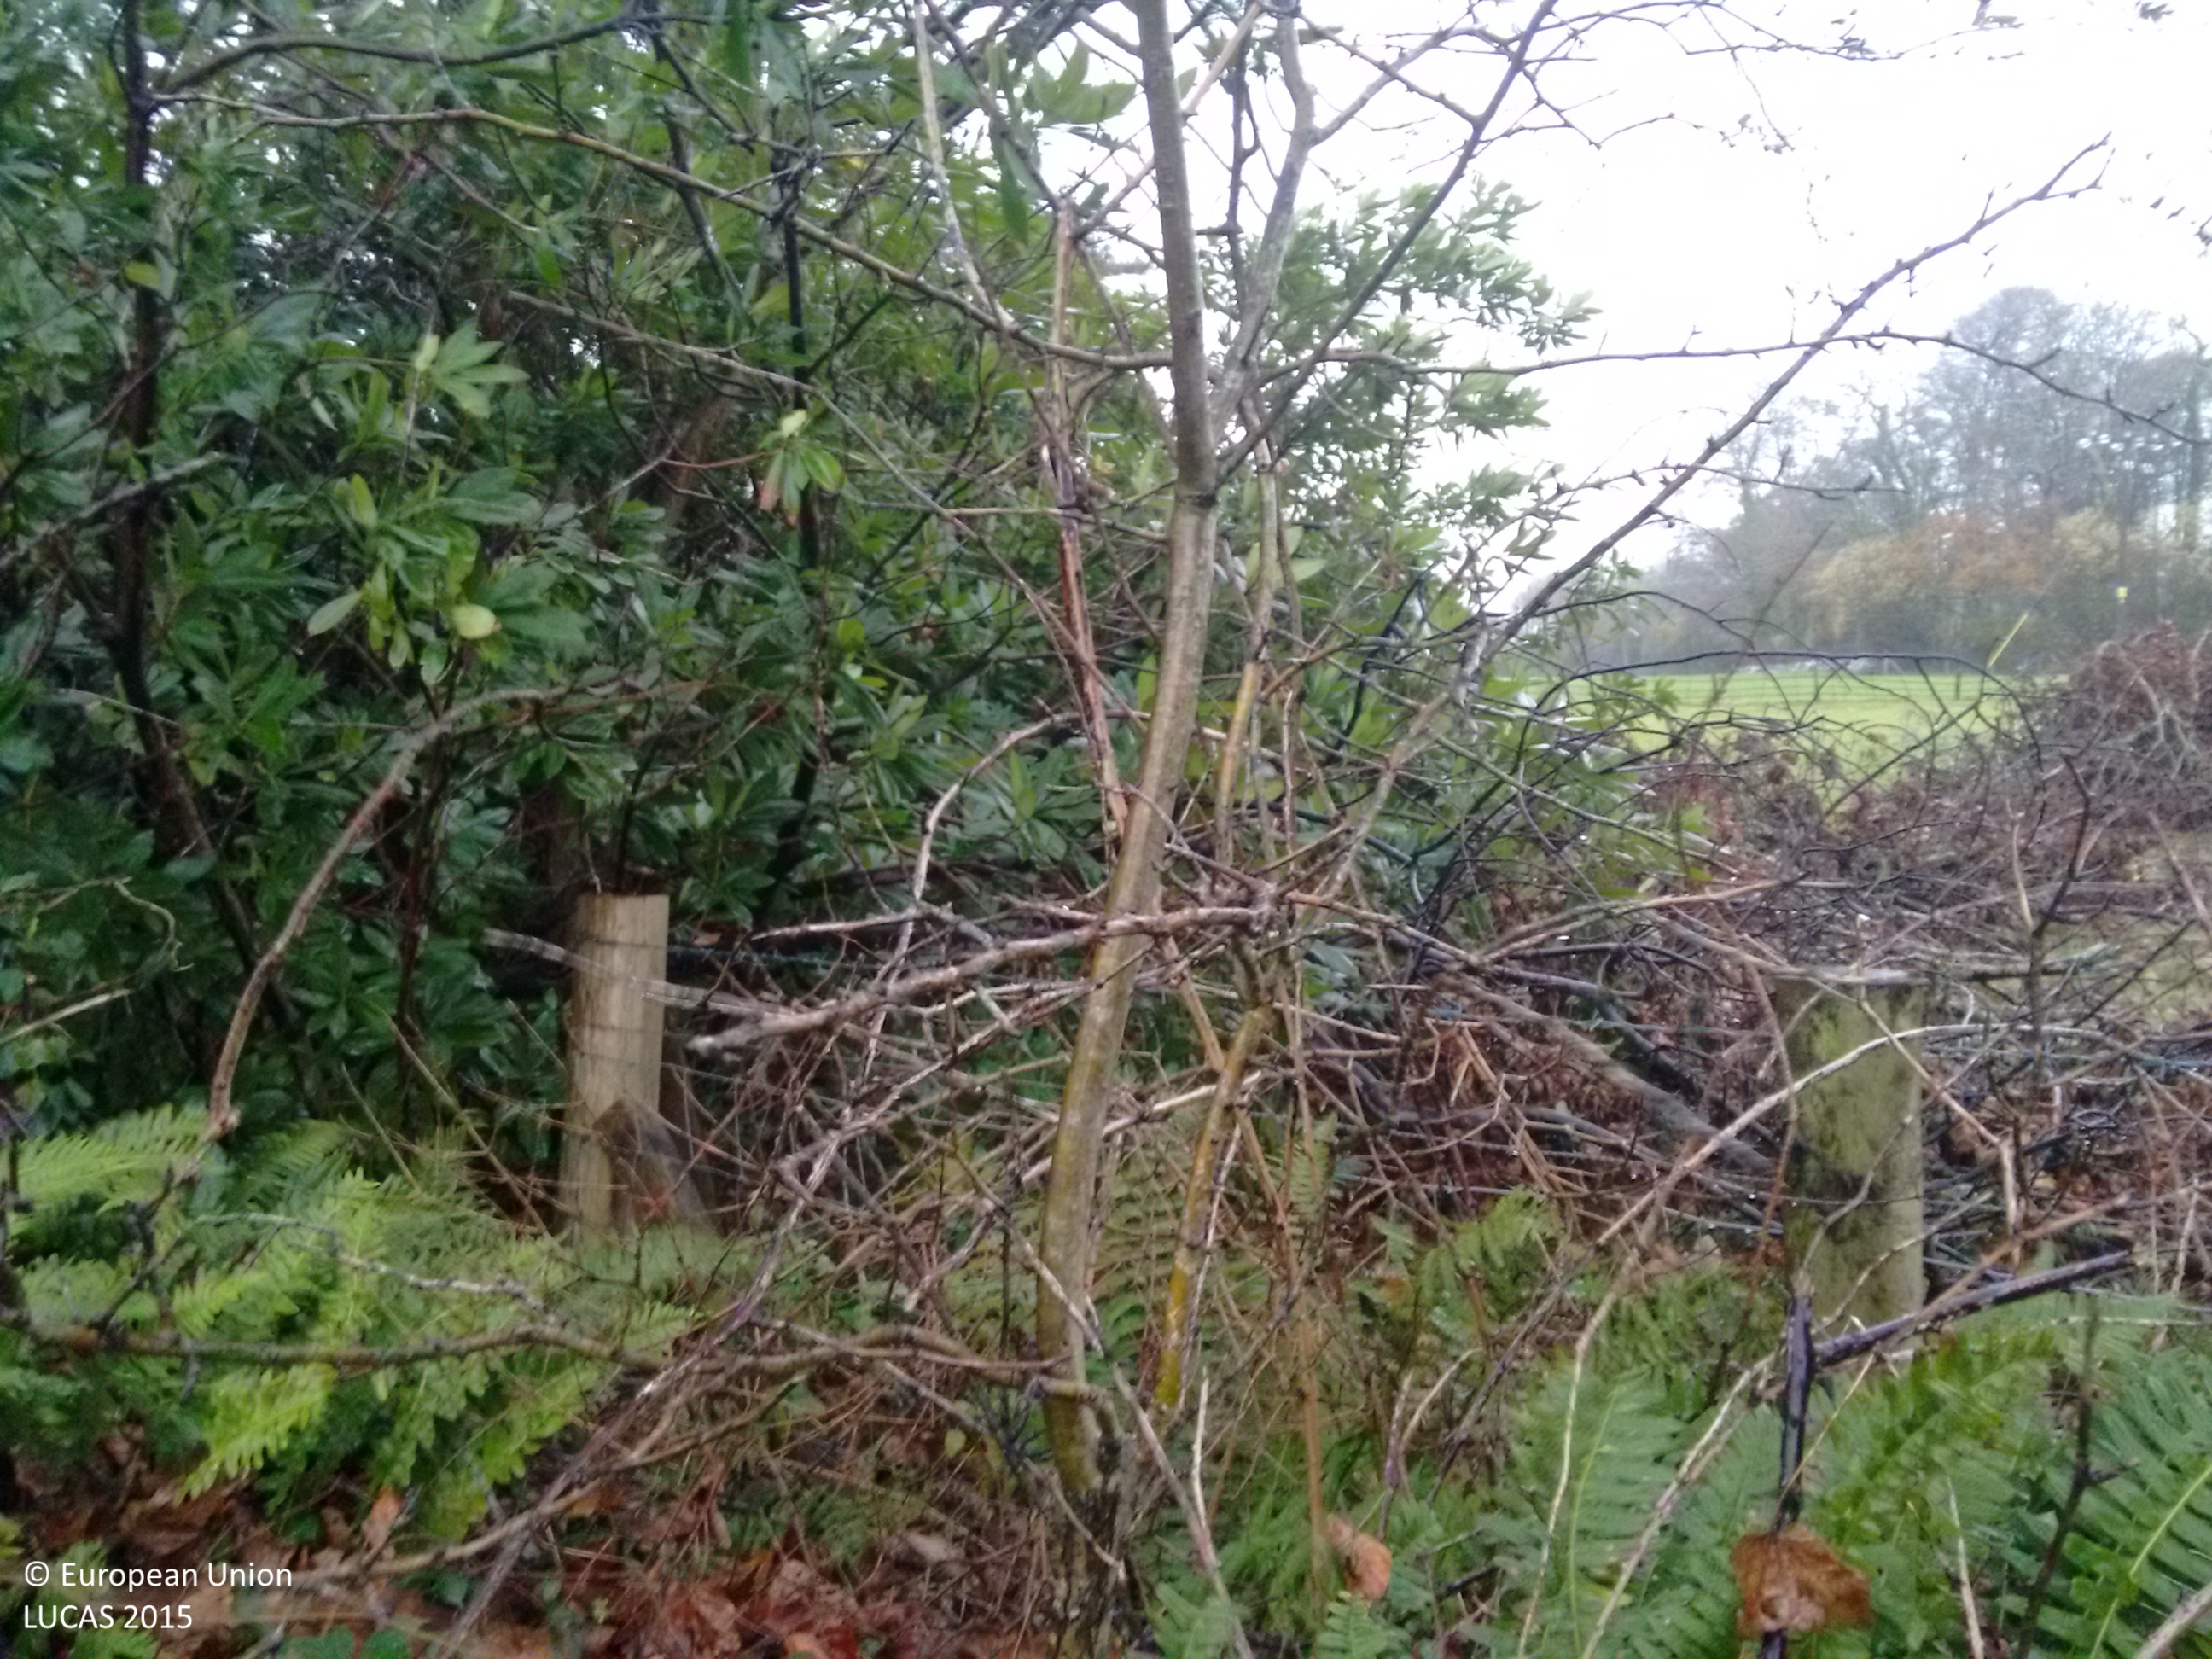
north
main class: Grassland
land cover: Grassland with sparse tree/shrub cover
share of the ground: > 75 %
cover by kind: herbaceous plants 95 %, broadleaved forest trees 5 %
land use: Amenities, museums, leisure
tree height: > 5 m
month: November
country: GB
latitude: 52.9195
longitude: -4.2437
